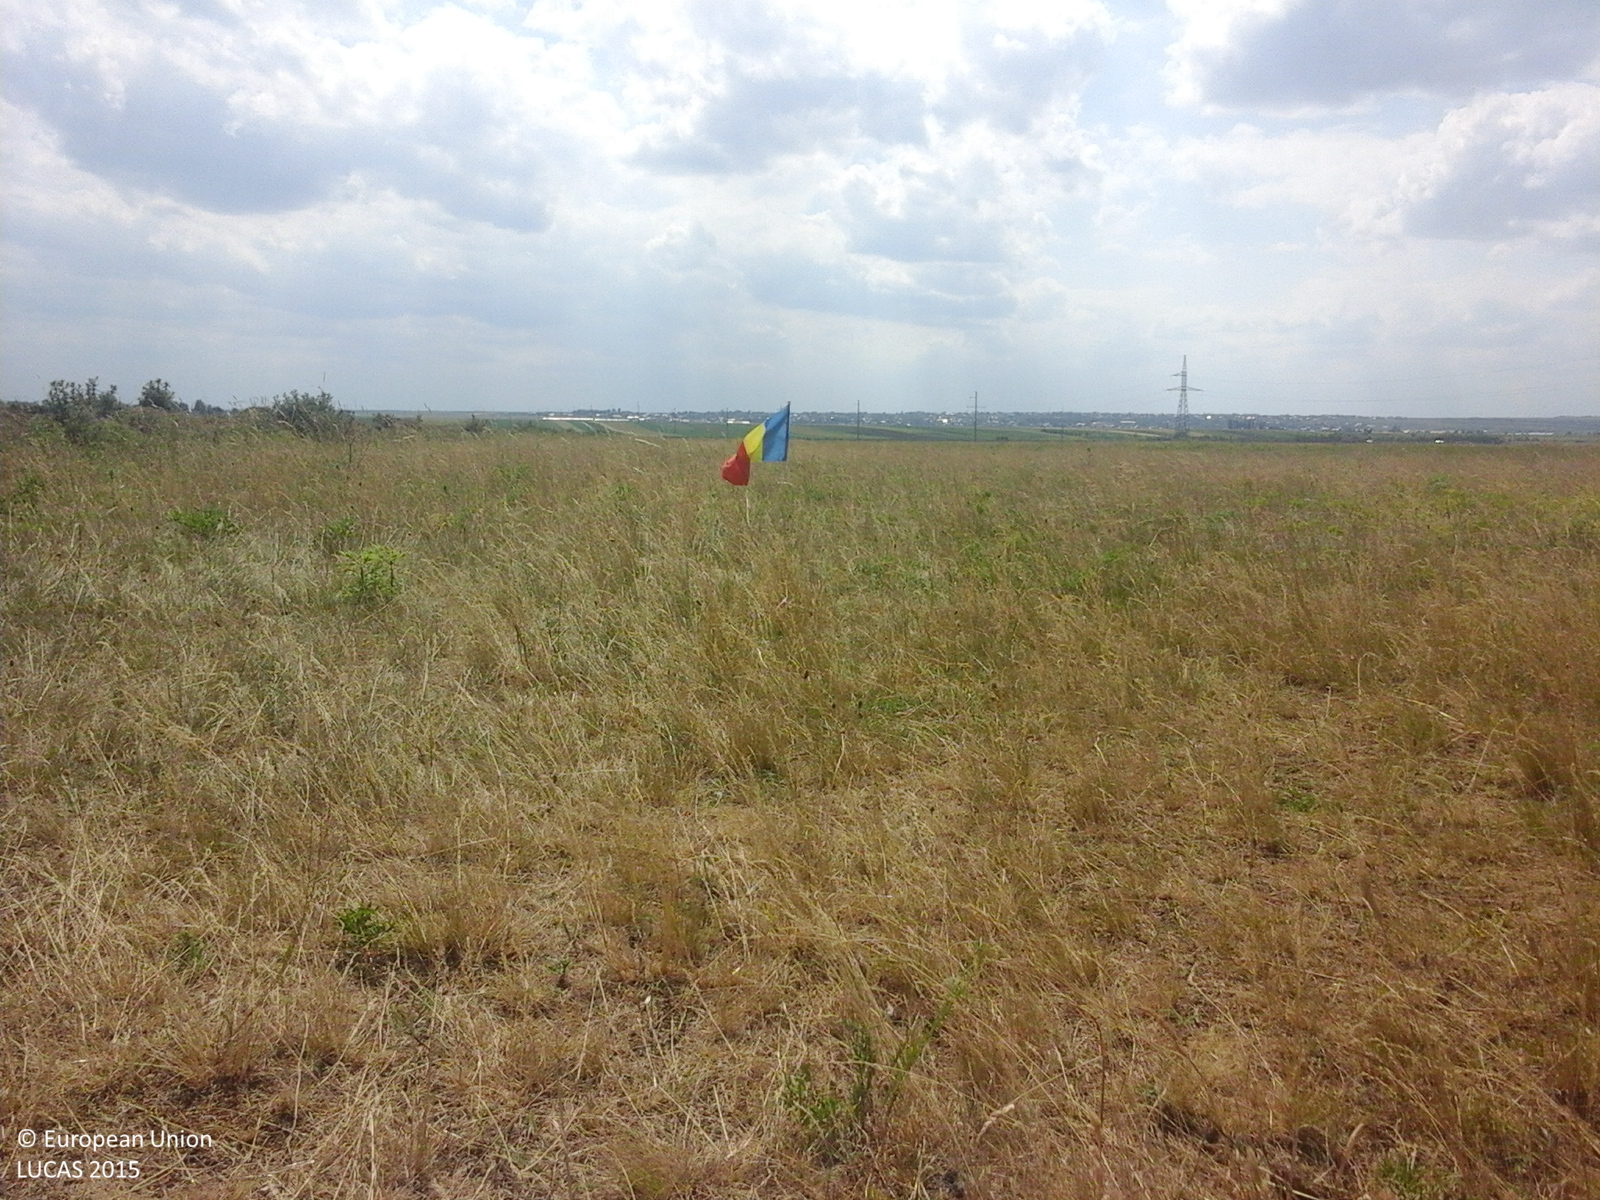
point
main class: Grassland
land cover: Grassland without tree/shrub cover
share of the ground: > 75 %
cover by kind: herbaceous plants 100 %
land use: Agriculture (excluding fallow land and kitchen gardens)
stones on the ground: < 10 %
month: June
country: RO
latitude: 47.6691
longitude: 26.4839
